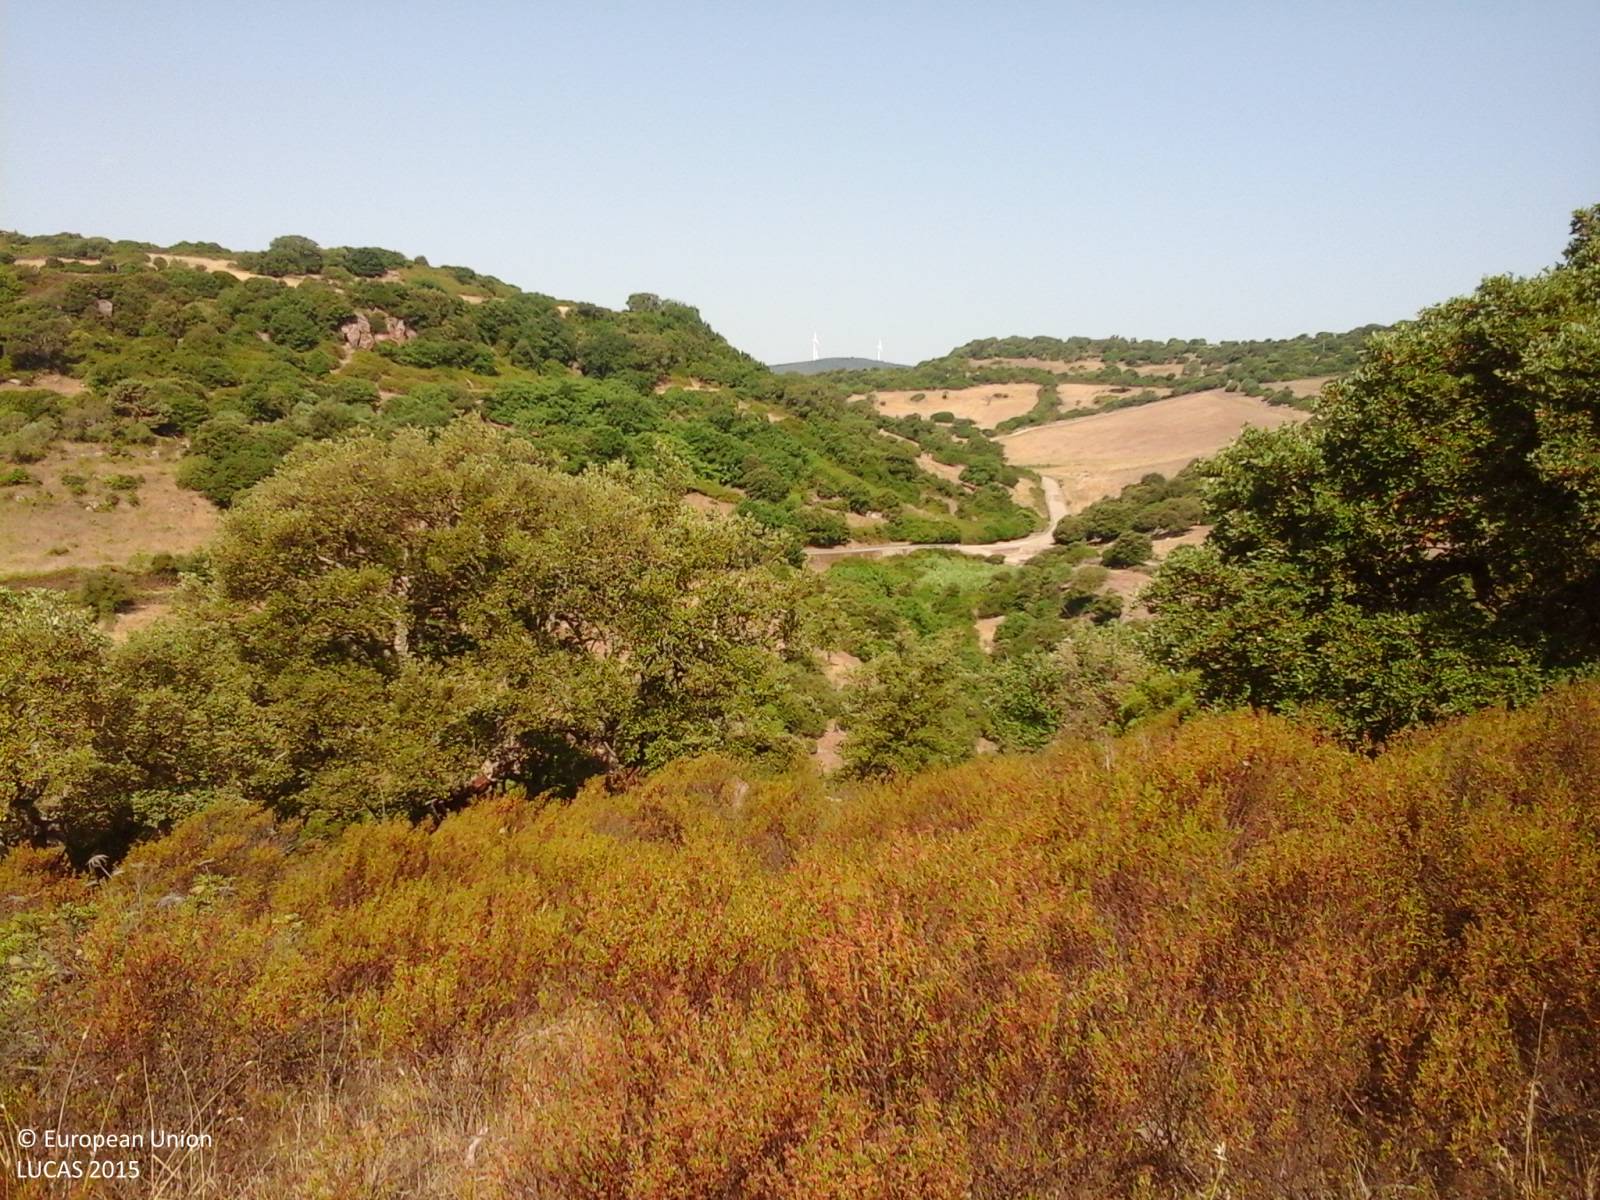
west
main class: Grassland
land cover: Grassland with sparse tree/shrub cover
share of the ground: > 75 %
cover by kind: herbaceous plants 85 %, shrubs 10 %, broadleaved forest trees 5 %
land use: Agriculture (excluding fallow land and kitchen gardens)
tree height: < 5 m
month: July
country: IT
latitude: 39.9171
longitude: 8.8947
